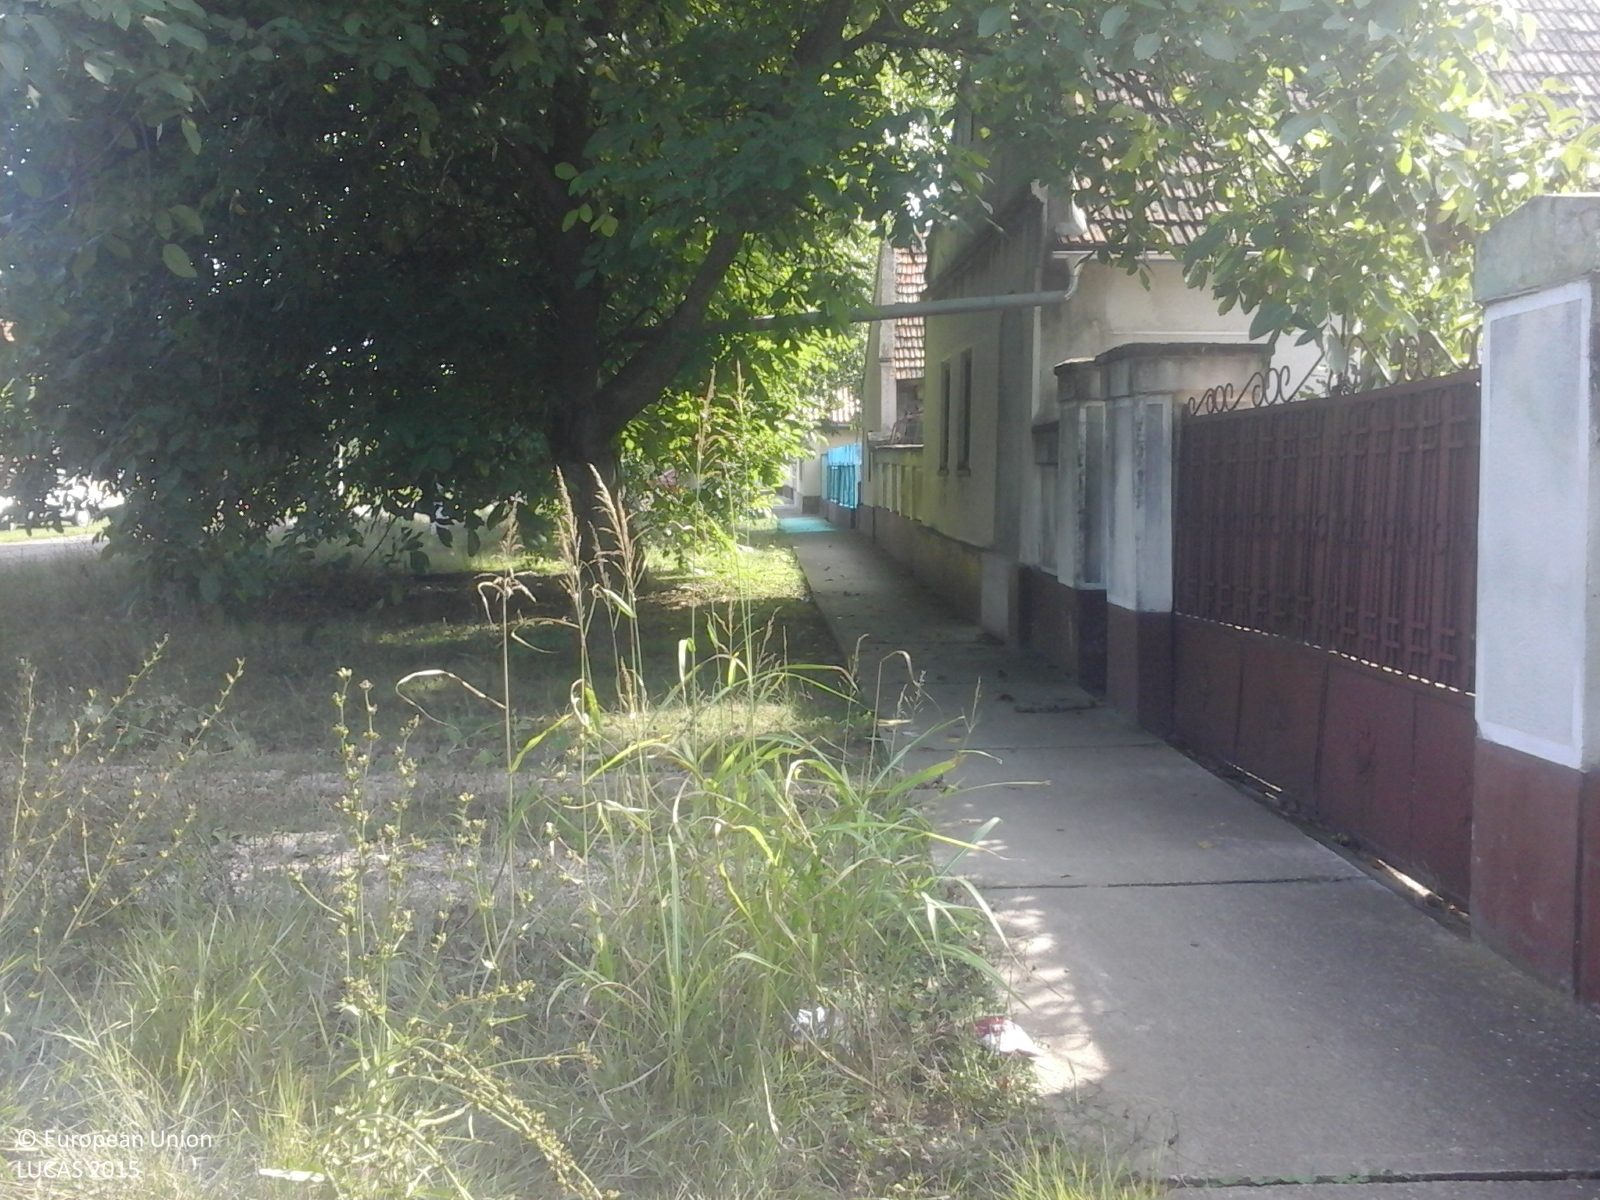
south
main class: Cropland
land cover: Vineyards
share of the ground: > 75 %
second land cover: Other bare soil
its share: > 75 %
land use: Kitchen garden
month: August
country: RO
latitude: 45.7617
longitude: 21.0213
